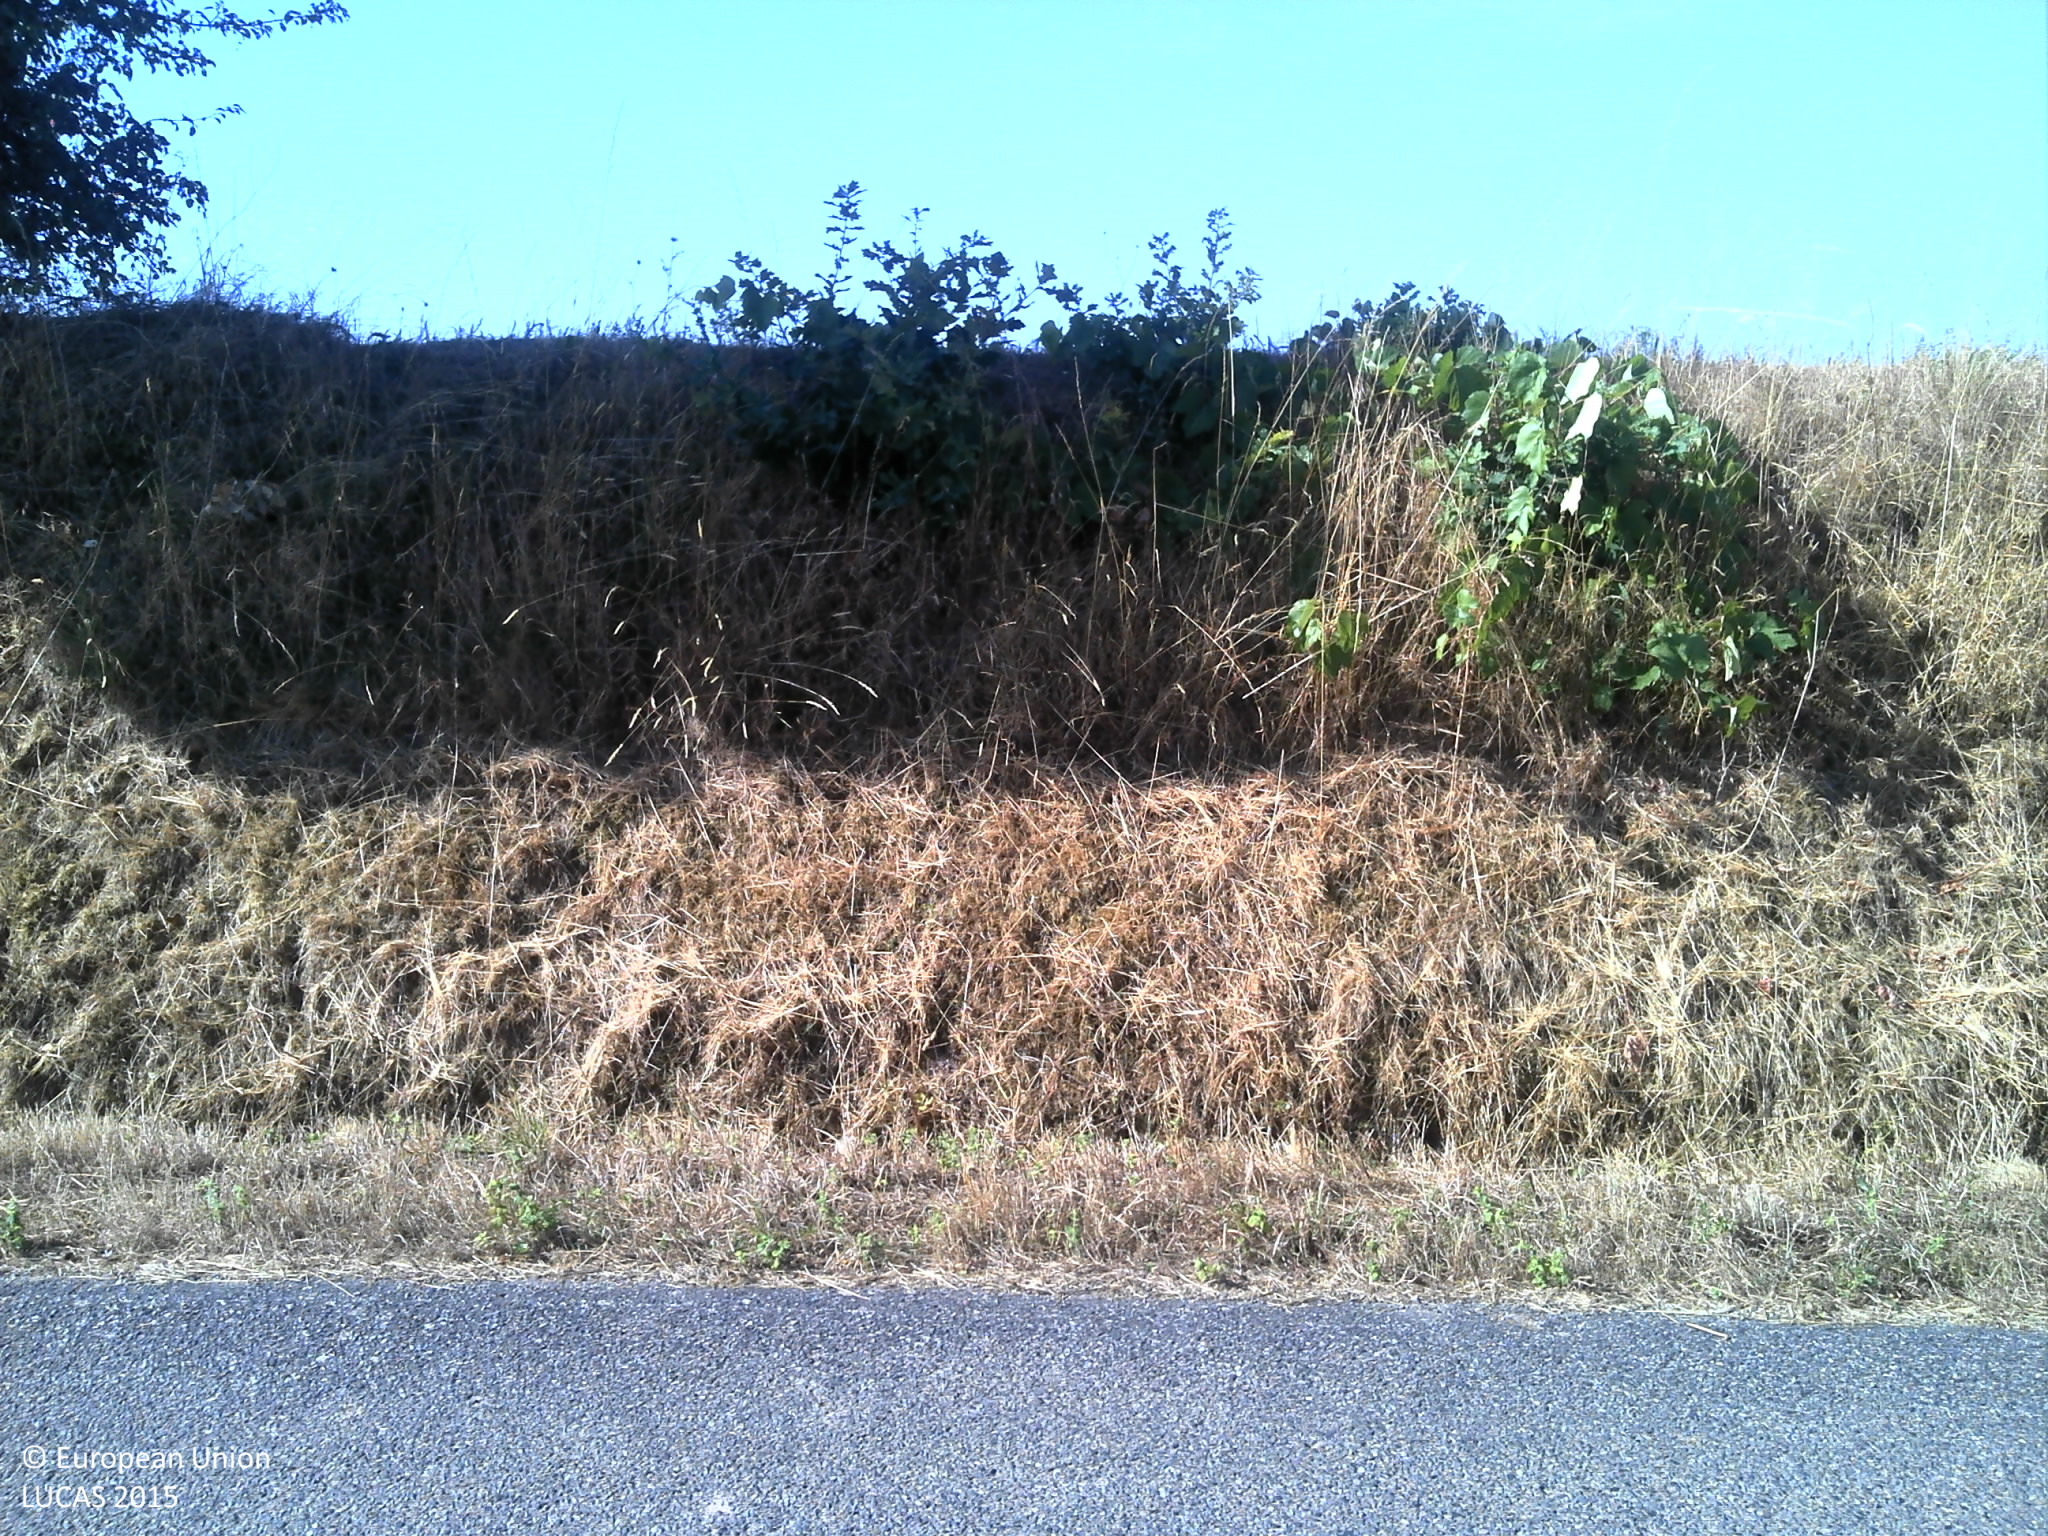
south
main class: Cropland
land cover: Mixed cereals for fodder
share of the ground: > 75 %
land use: Agriculture (excluding fallow land and kitchen gardens)
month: July
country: FR
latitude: 45.0190
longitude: 1.7613
